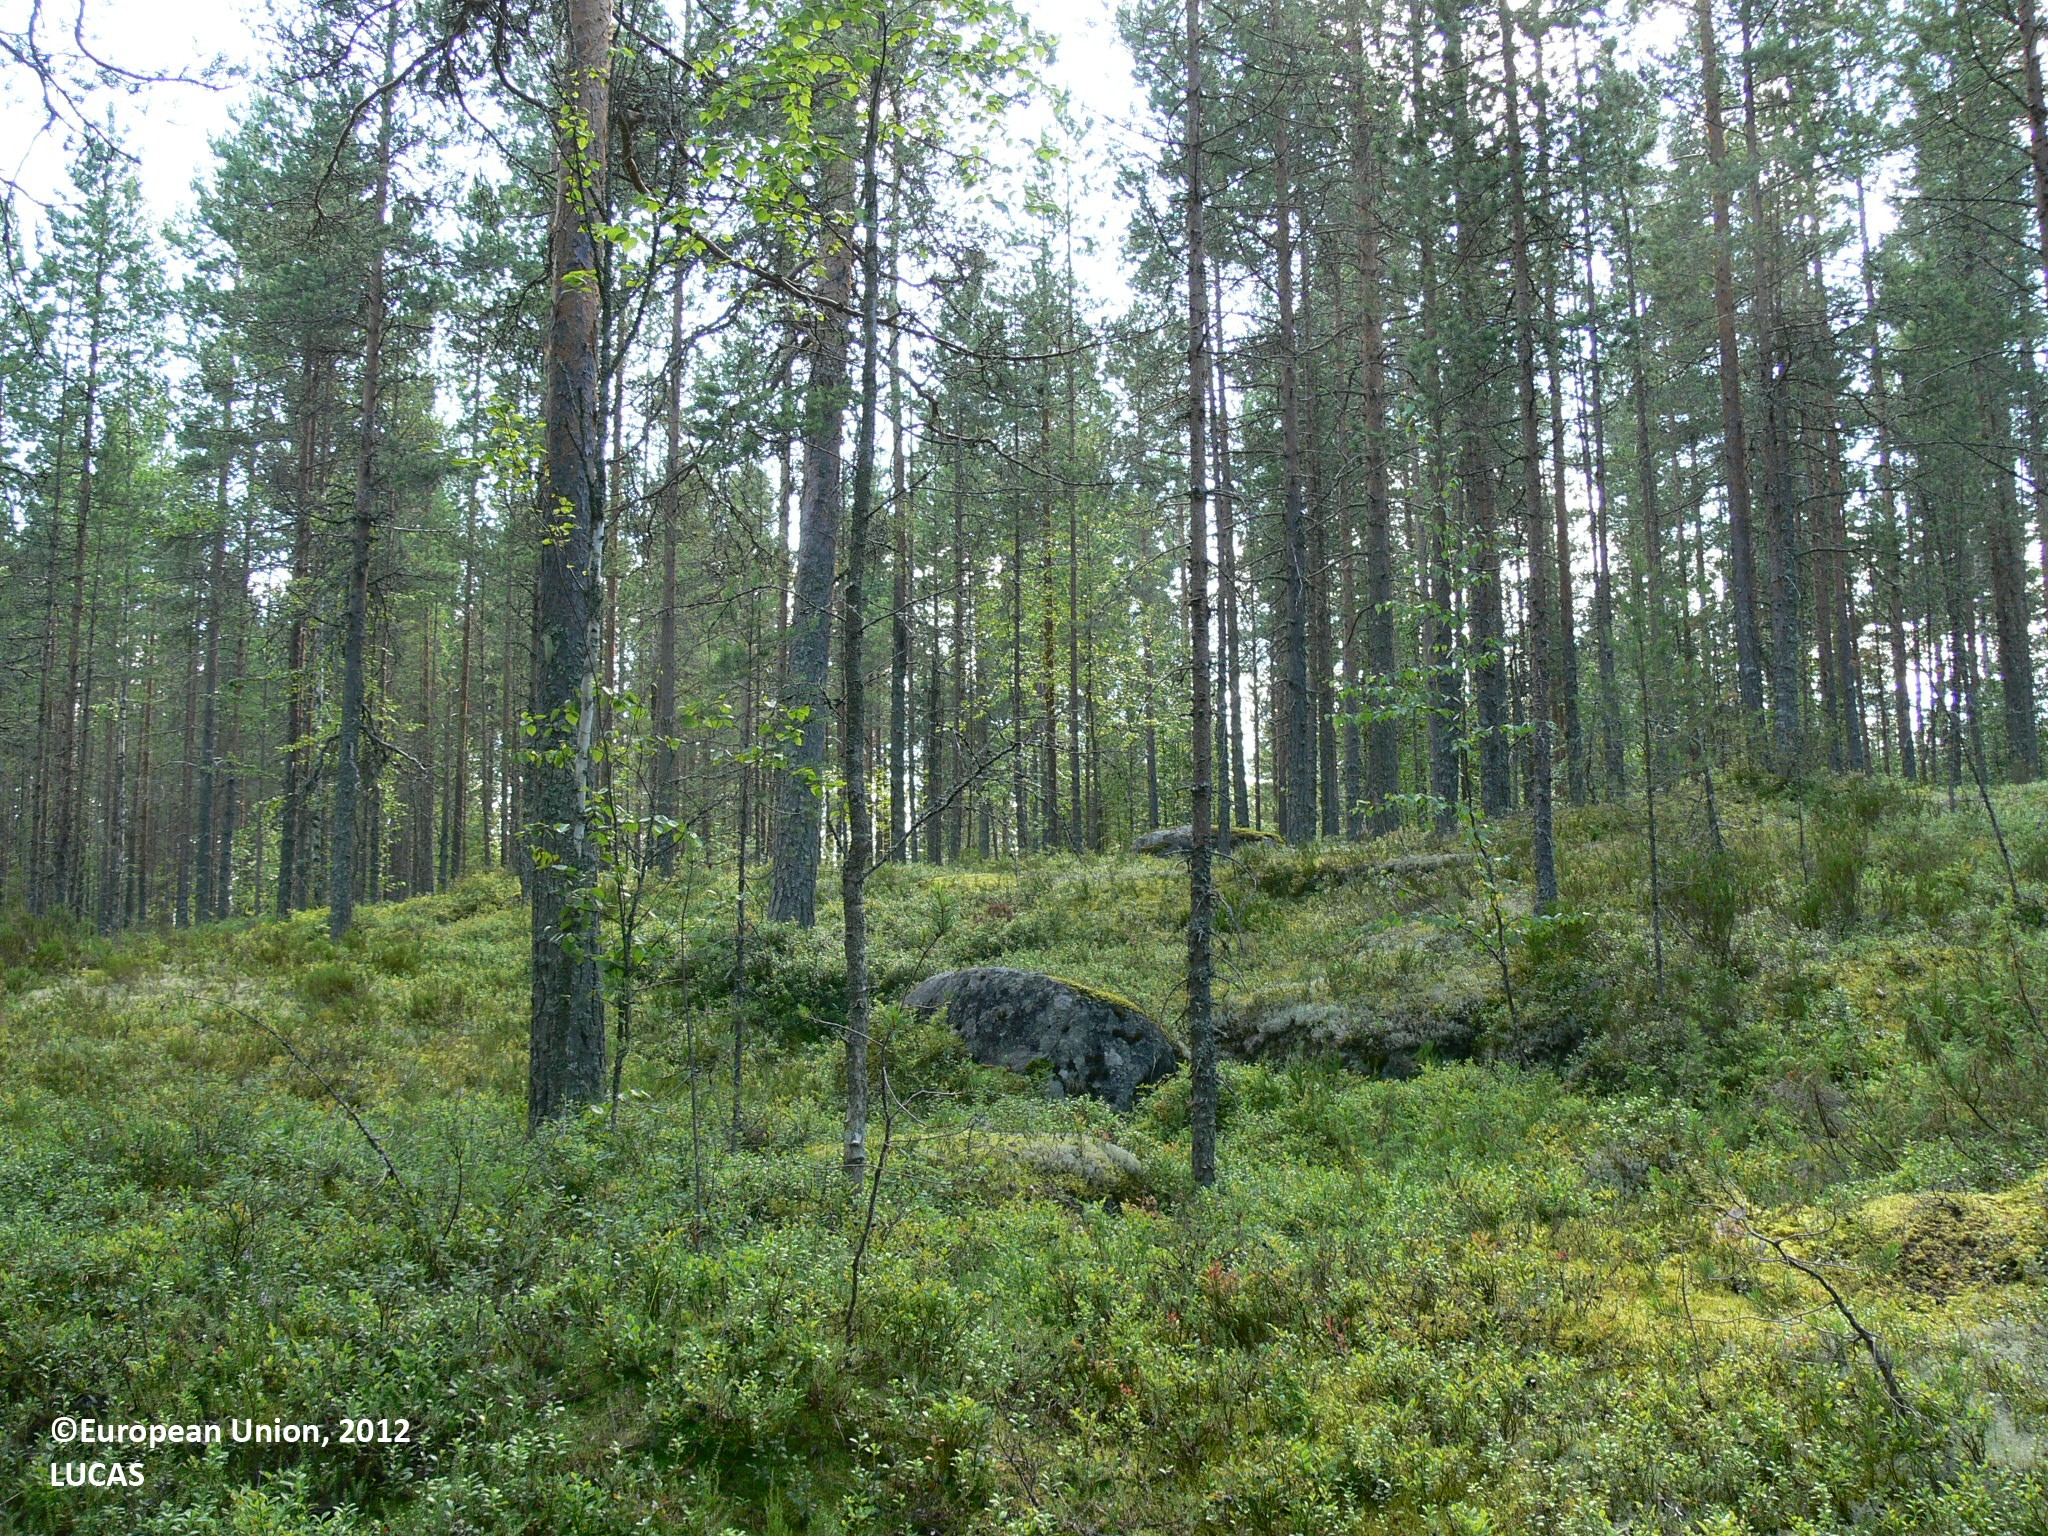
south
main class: Woodland
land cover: Pine dominated coniferous woodland
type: boreal forest
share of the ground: 50 - 75 %
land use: Forestry
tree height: > 5 m
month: July
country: FI
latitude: 63.2866
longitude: 29.3040
